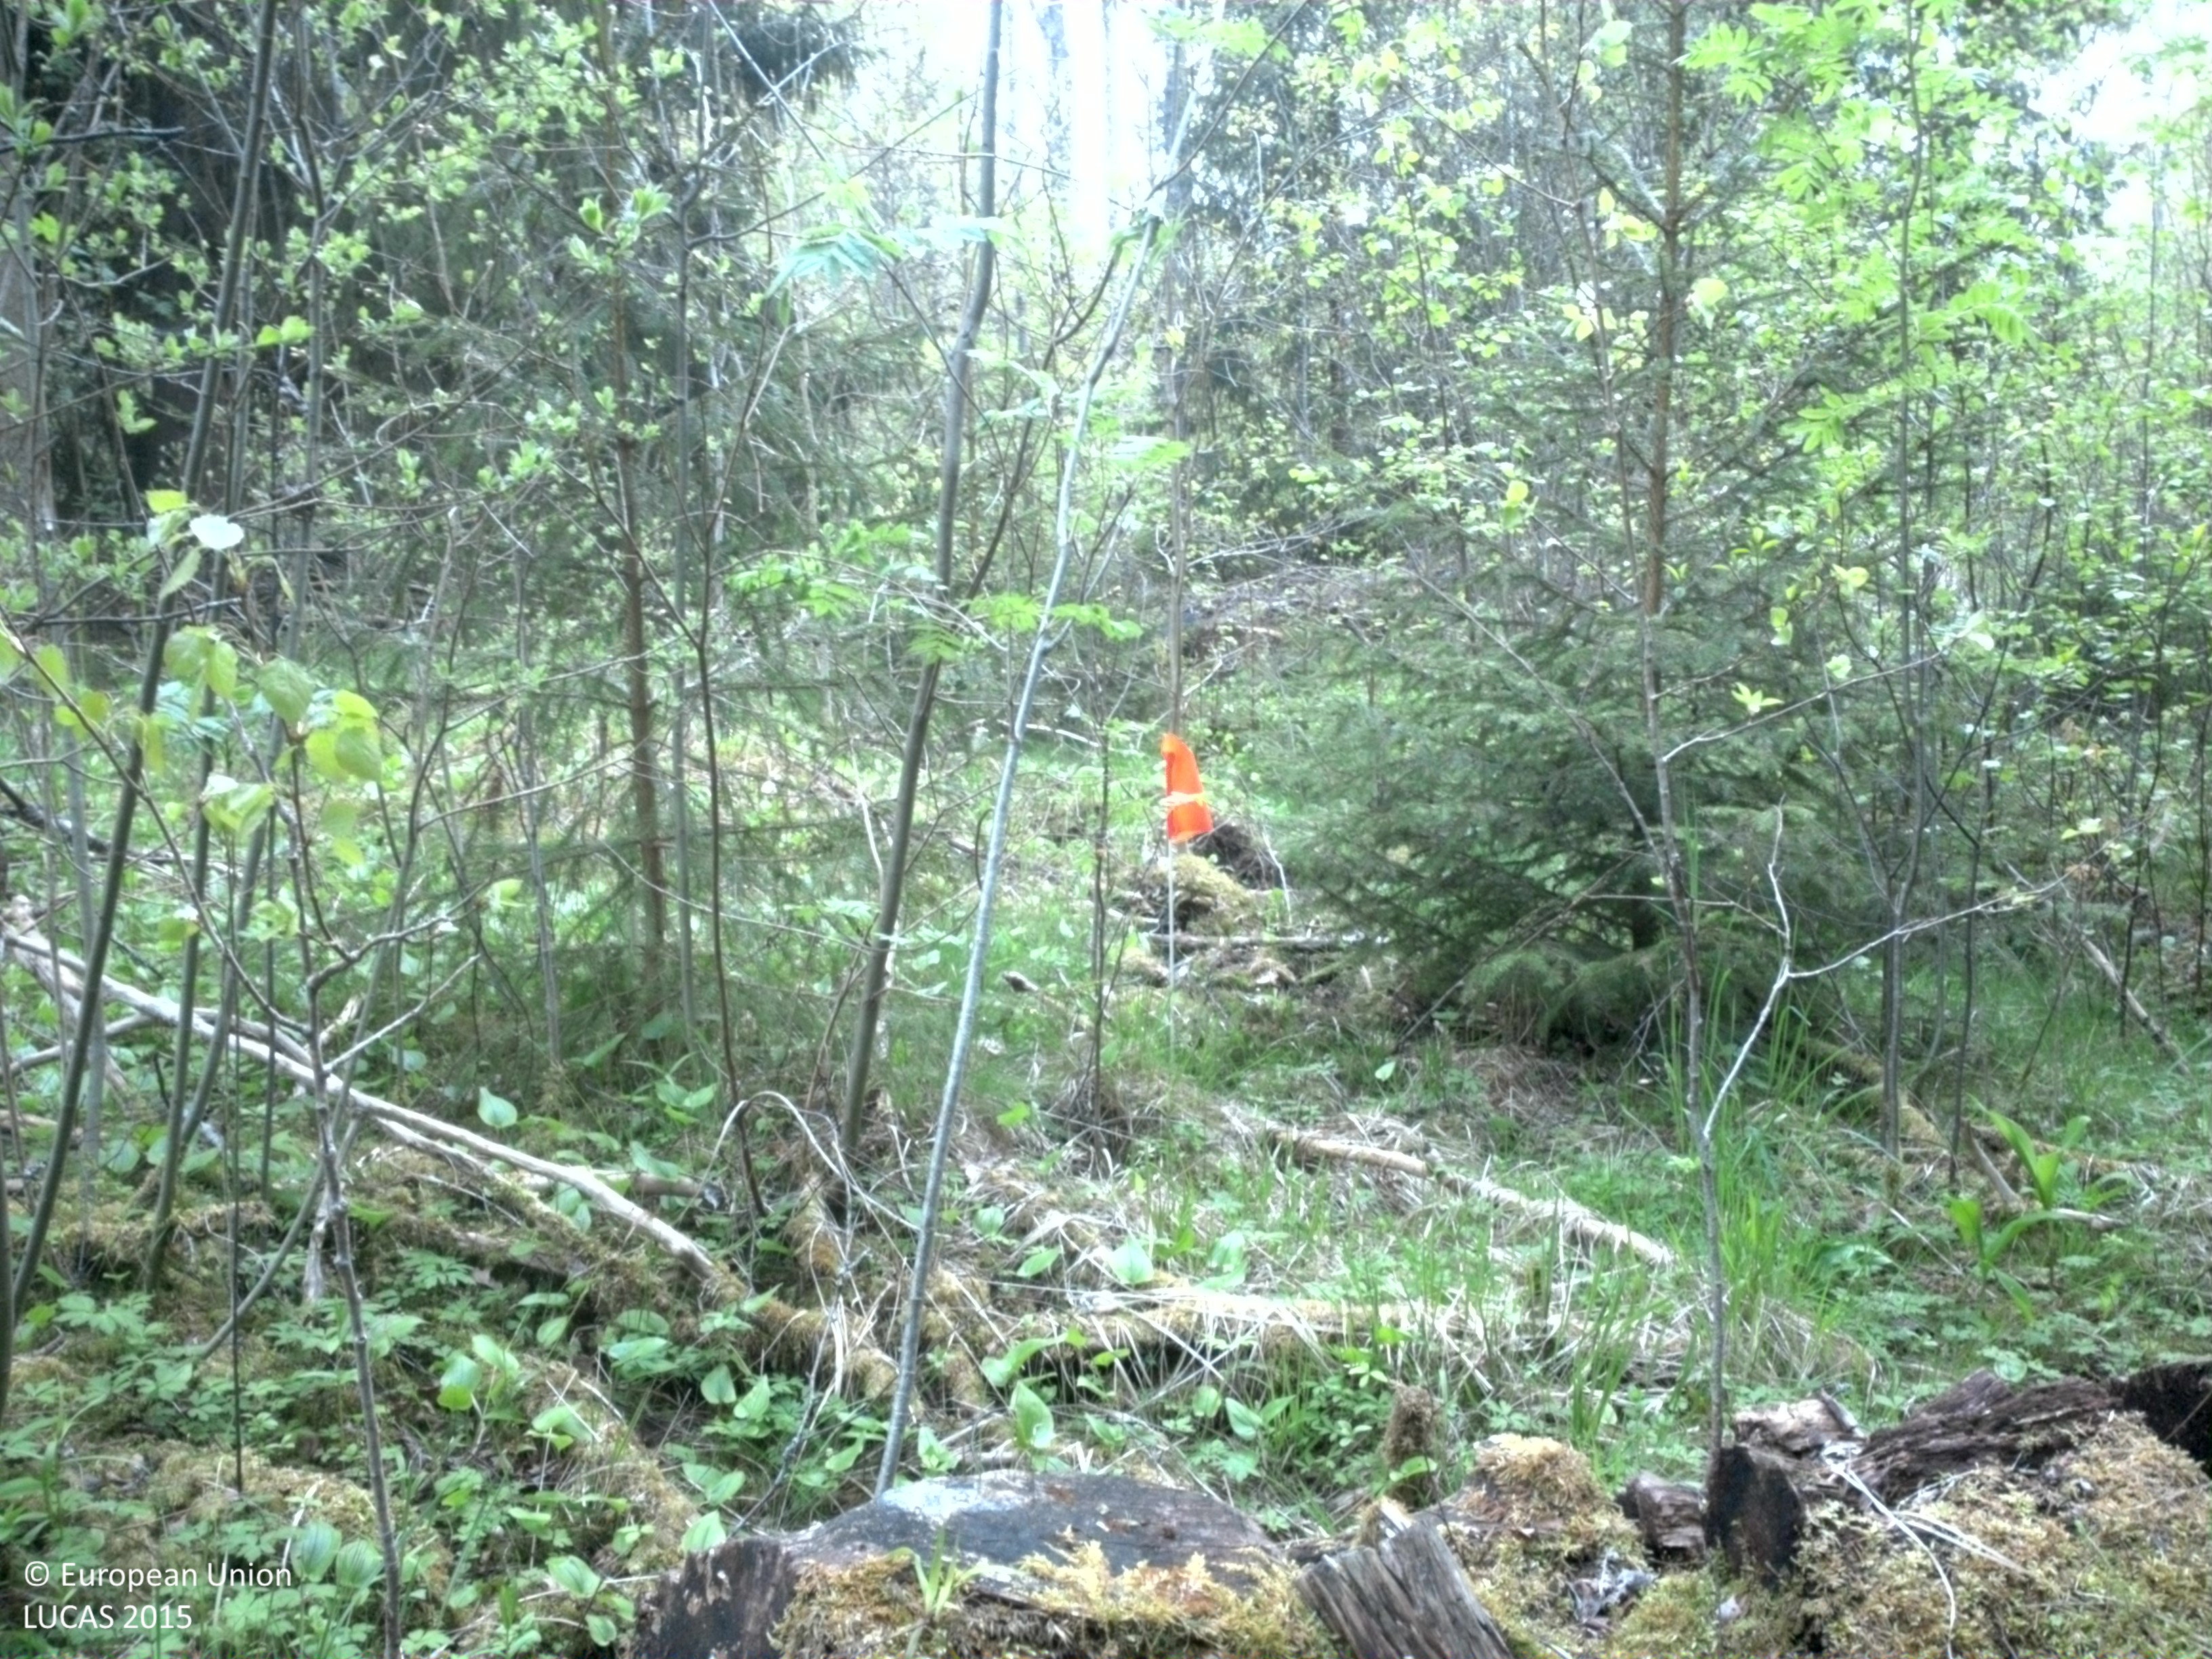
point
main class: Woodland
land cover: Broadleaved woodland
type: boreal forest
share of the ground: 50 - 75 %
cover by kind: broadleaved forest trees 65 %, shrubs 15 %, coniferous forest trees 10 %, herbaceous plants 10 %
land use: Forestry
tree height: > 5 m
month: May
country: SE
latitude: 56.6397
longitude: 15.2322
